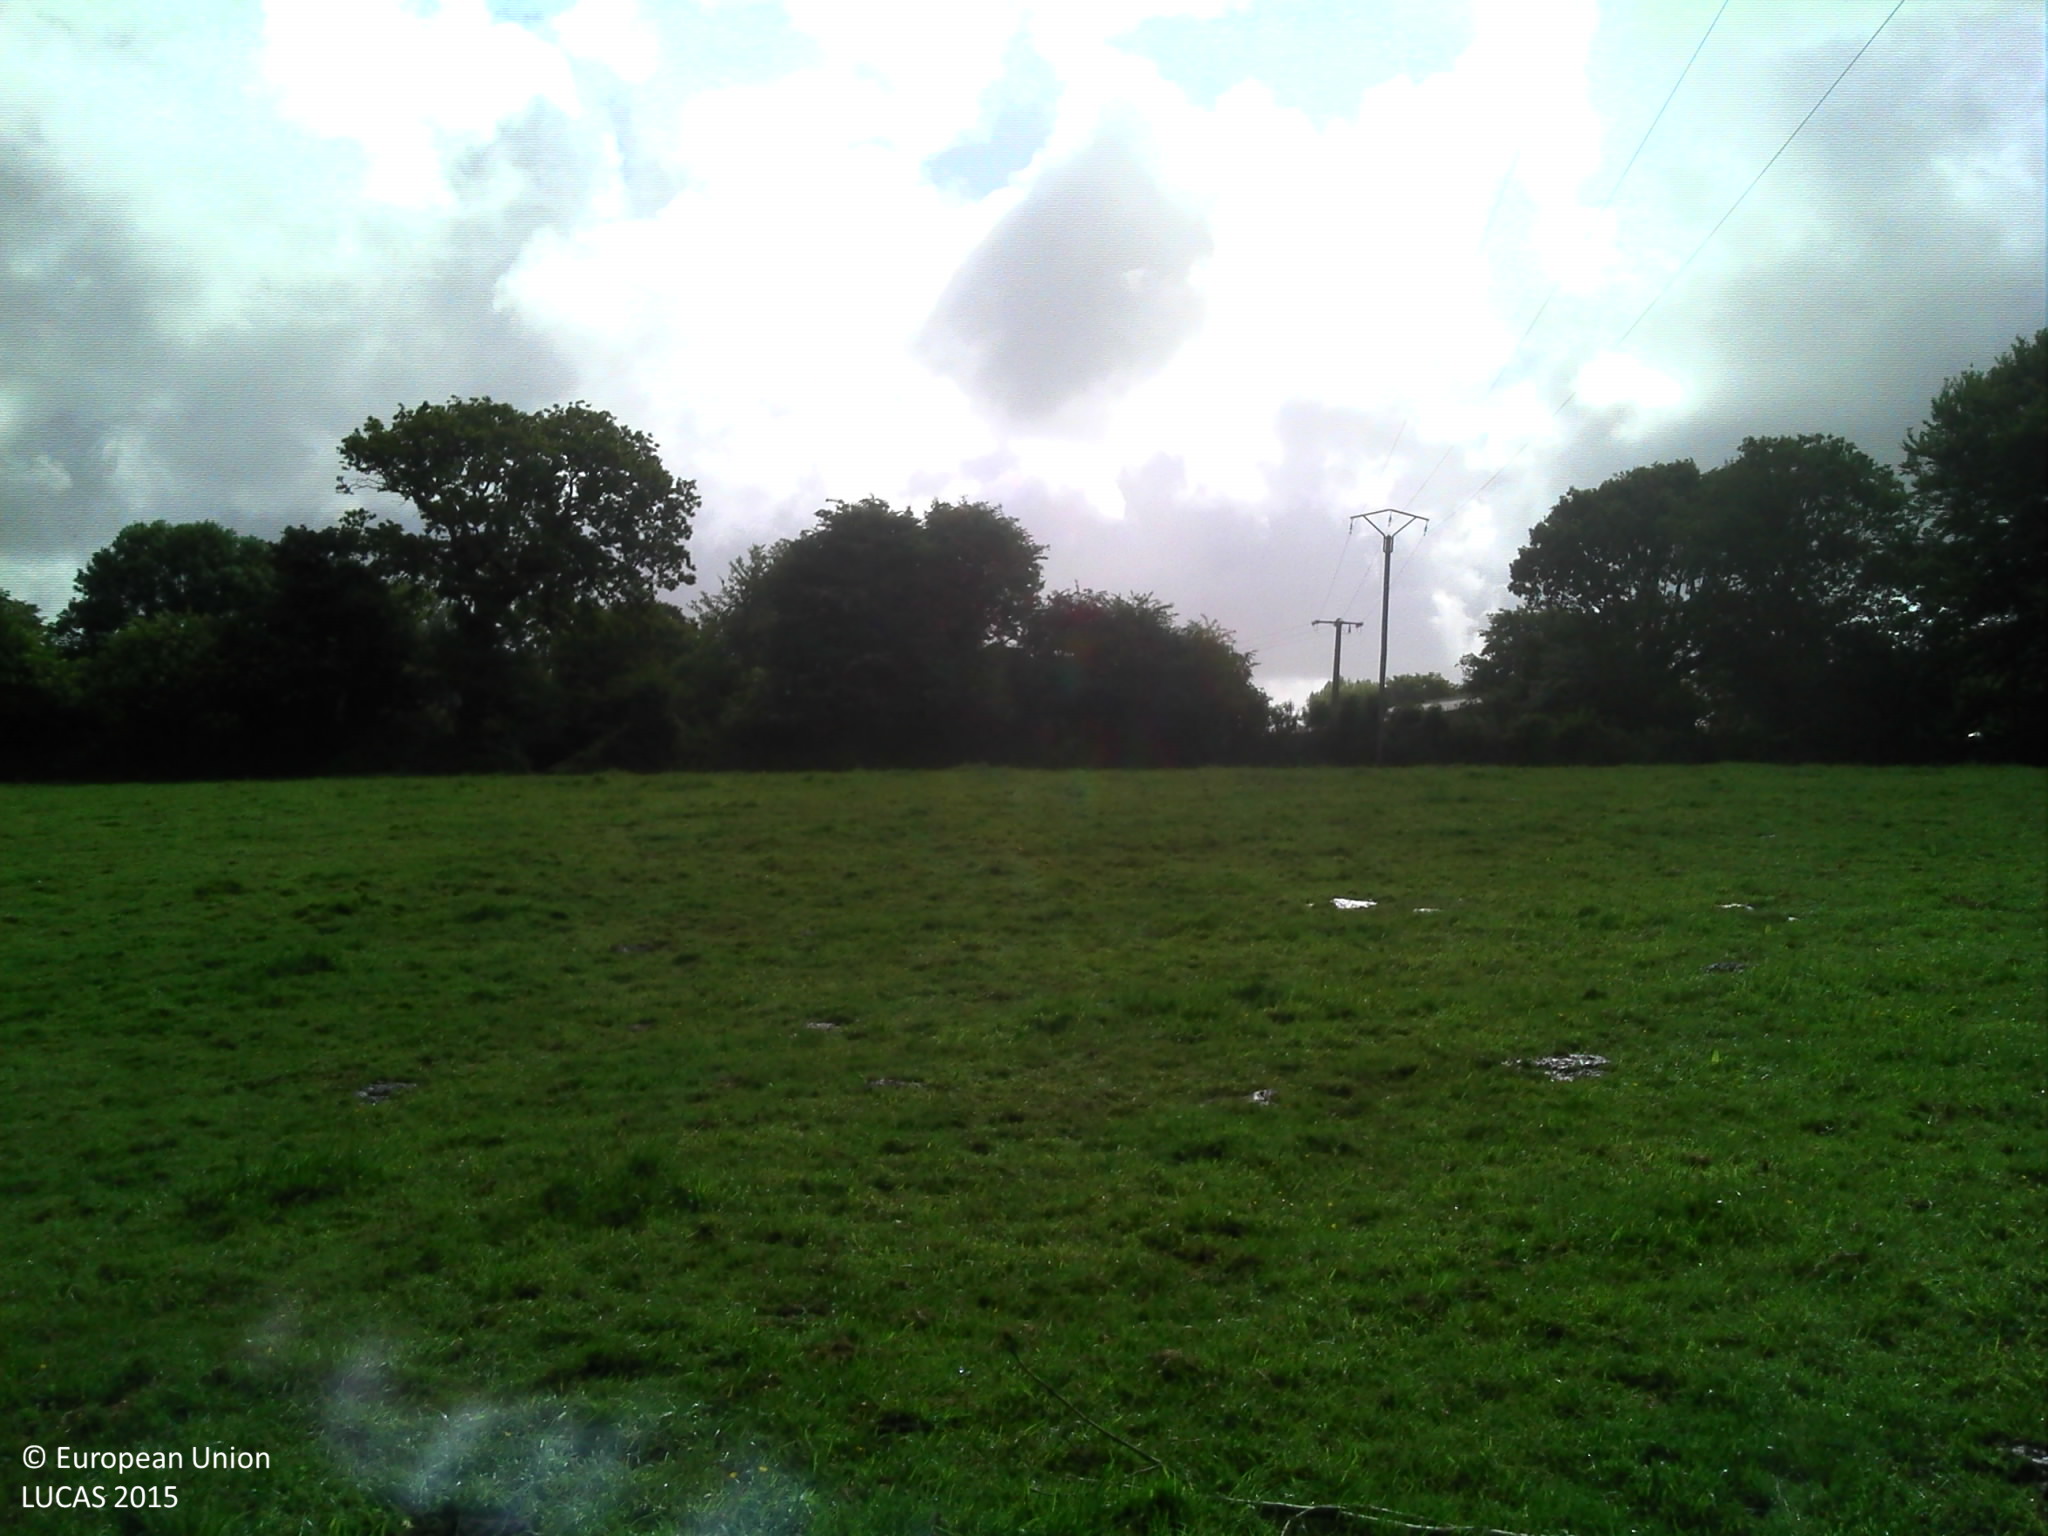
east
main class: Grassland
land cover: Grassland without tree/shrub cover
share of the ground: > 75 %
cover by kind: herbaceous plants 100 %
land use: Agriculture (excluding fallow land and kitchen gardens)
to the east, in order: Abandoned hedges; Grassland without tree/shrub cover; Electric lines; Grassland without tree/shrub cover; Abandoned hedges; Grassland without tree/shrub cover; Broadleaved woodland; Artificial constructions in urban areas; Grassland without tree/shrub cover; Abandoned hedges; Grassland without tree/shrub cover
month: June
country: FR
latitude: 49.5519
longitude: -1.7890
